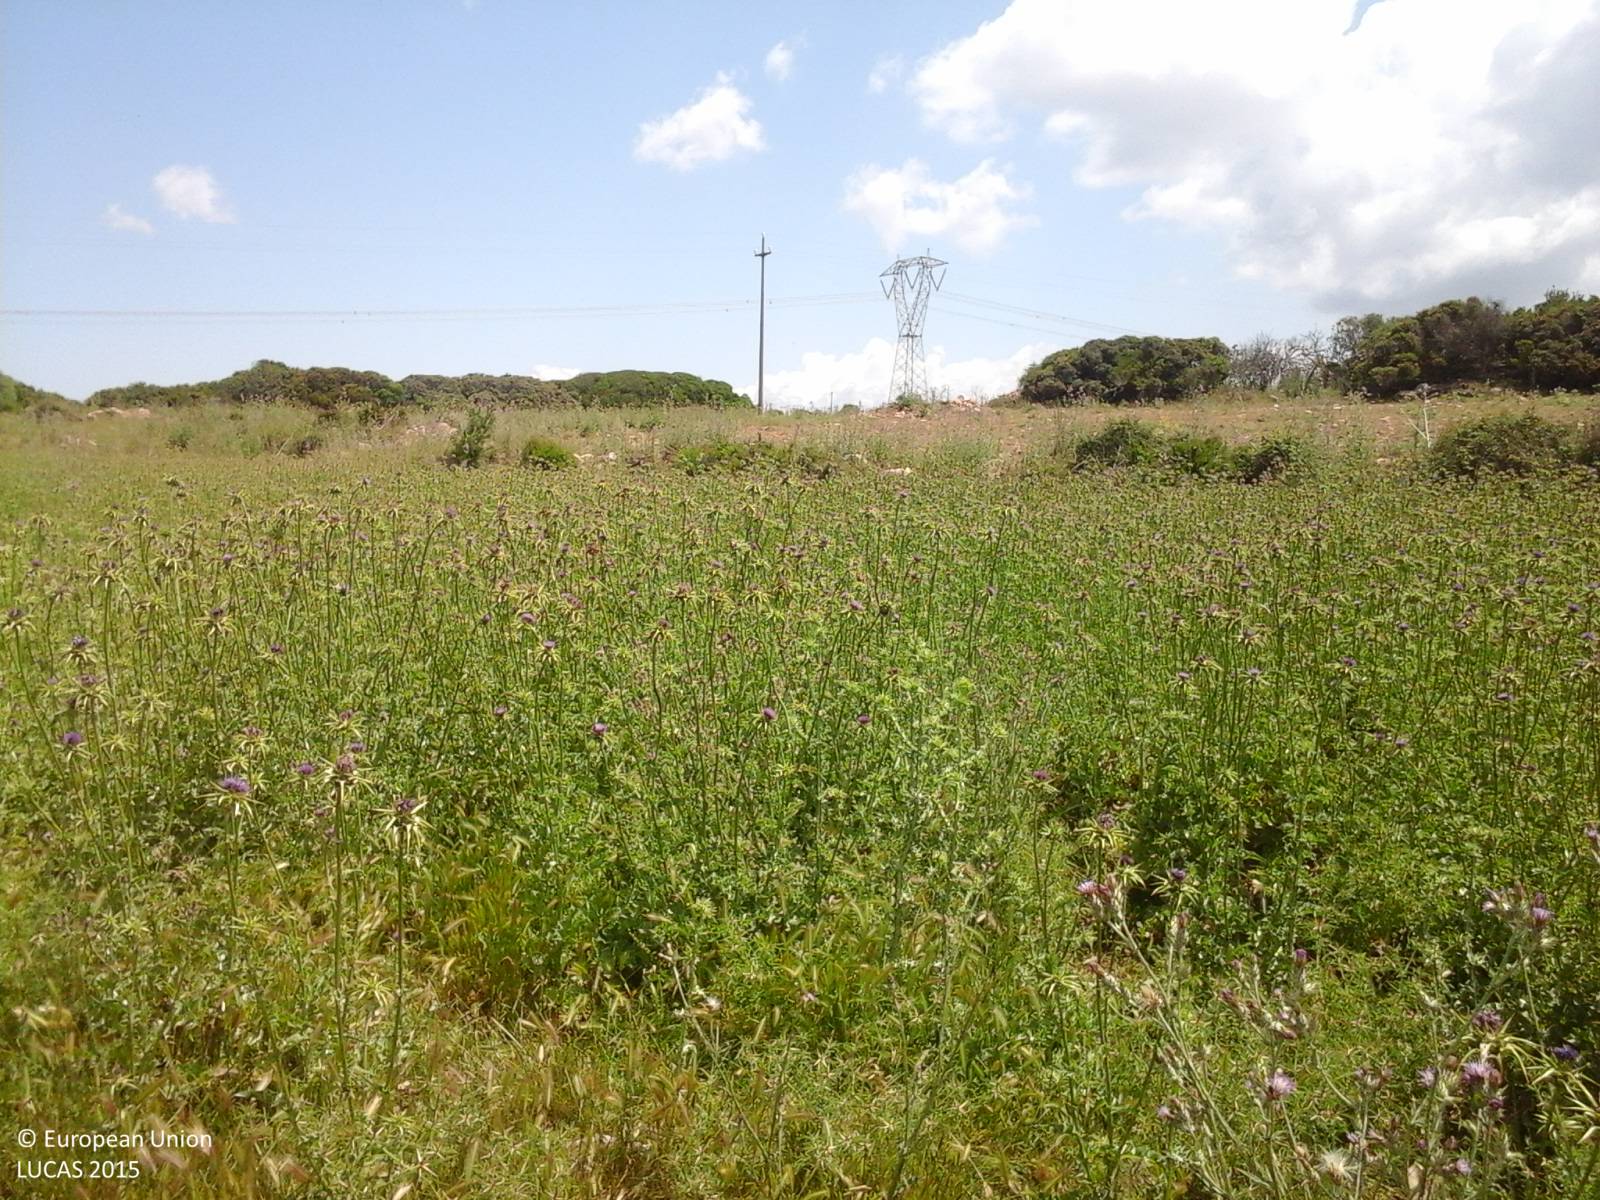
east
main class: Grassland
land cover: Spontaneously vegetated surfaces
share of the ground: > 75 %
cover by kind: herbaceous plants 50 %, shrubs 5 %, unconsolidated bare surface 5 %
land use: Agriculture (excluding fallow land and kitchen gardens)
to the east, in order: Spontaneously vegetated surfaces; Dry stone walls; Spontaneously vegetated surfaces; Shruby margins; Spontaneously vegetated surfaces; Electric lines; Spontaneously vegetated surfaces; Dry stone walls; Fences; Grass margins; Durum wheat
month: May
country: IT
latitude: 40.7428
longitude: 8.3853
